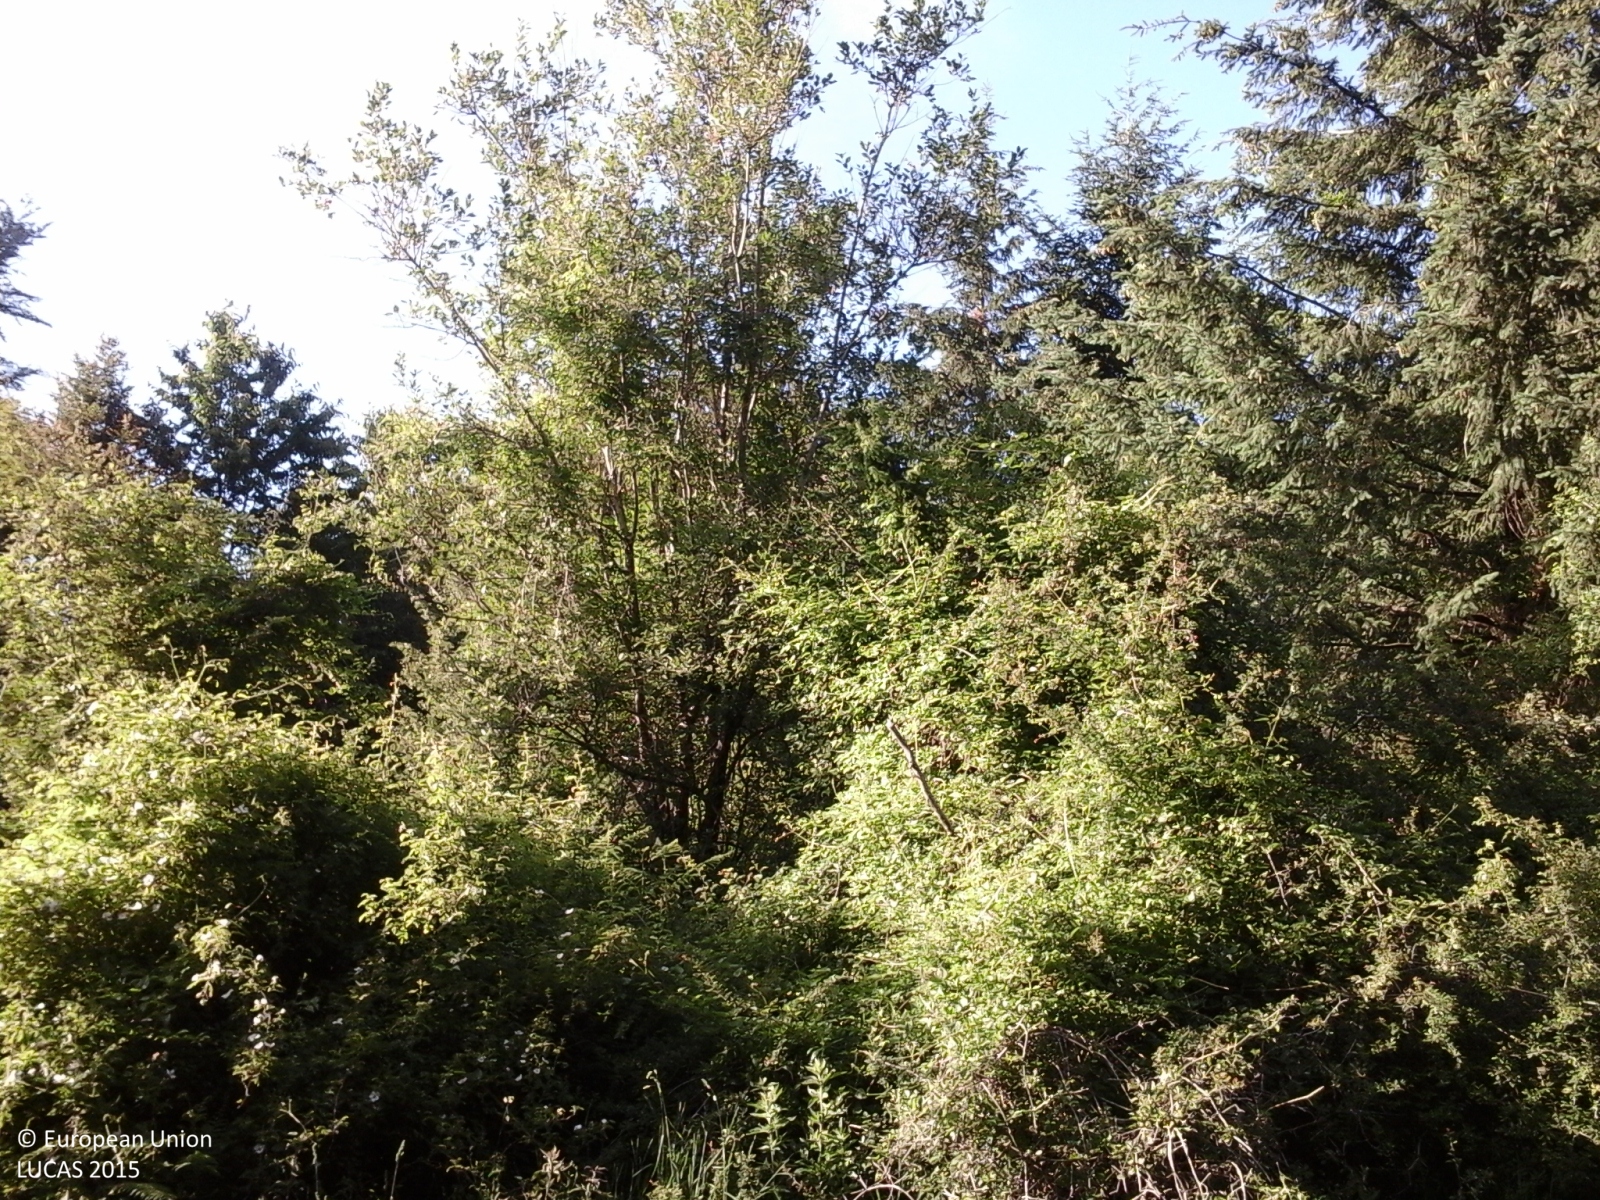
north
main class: Grassland
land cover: Grassland without tree/shrub cover
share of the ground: > 75 %
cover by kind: herbaceous plants 95 %, shrubs 5 %
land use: Agriculture (excluding fallow land and kitchen gardens)
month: June
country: IT
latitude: 43.8860
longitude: 11.6762
